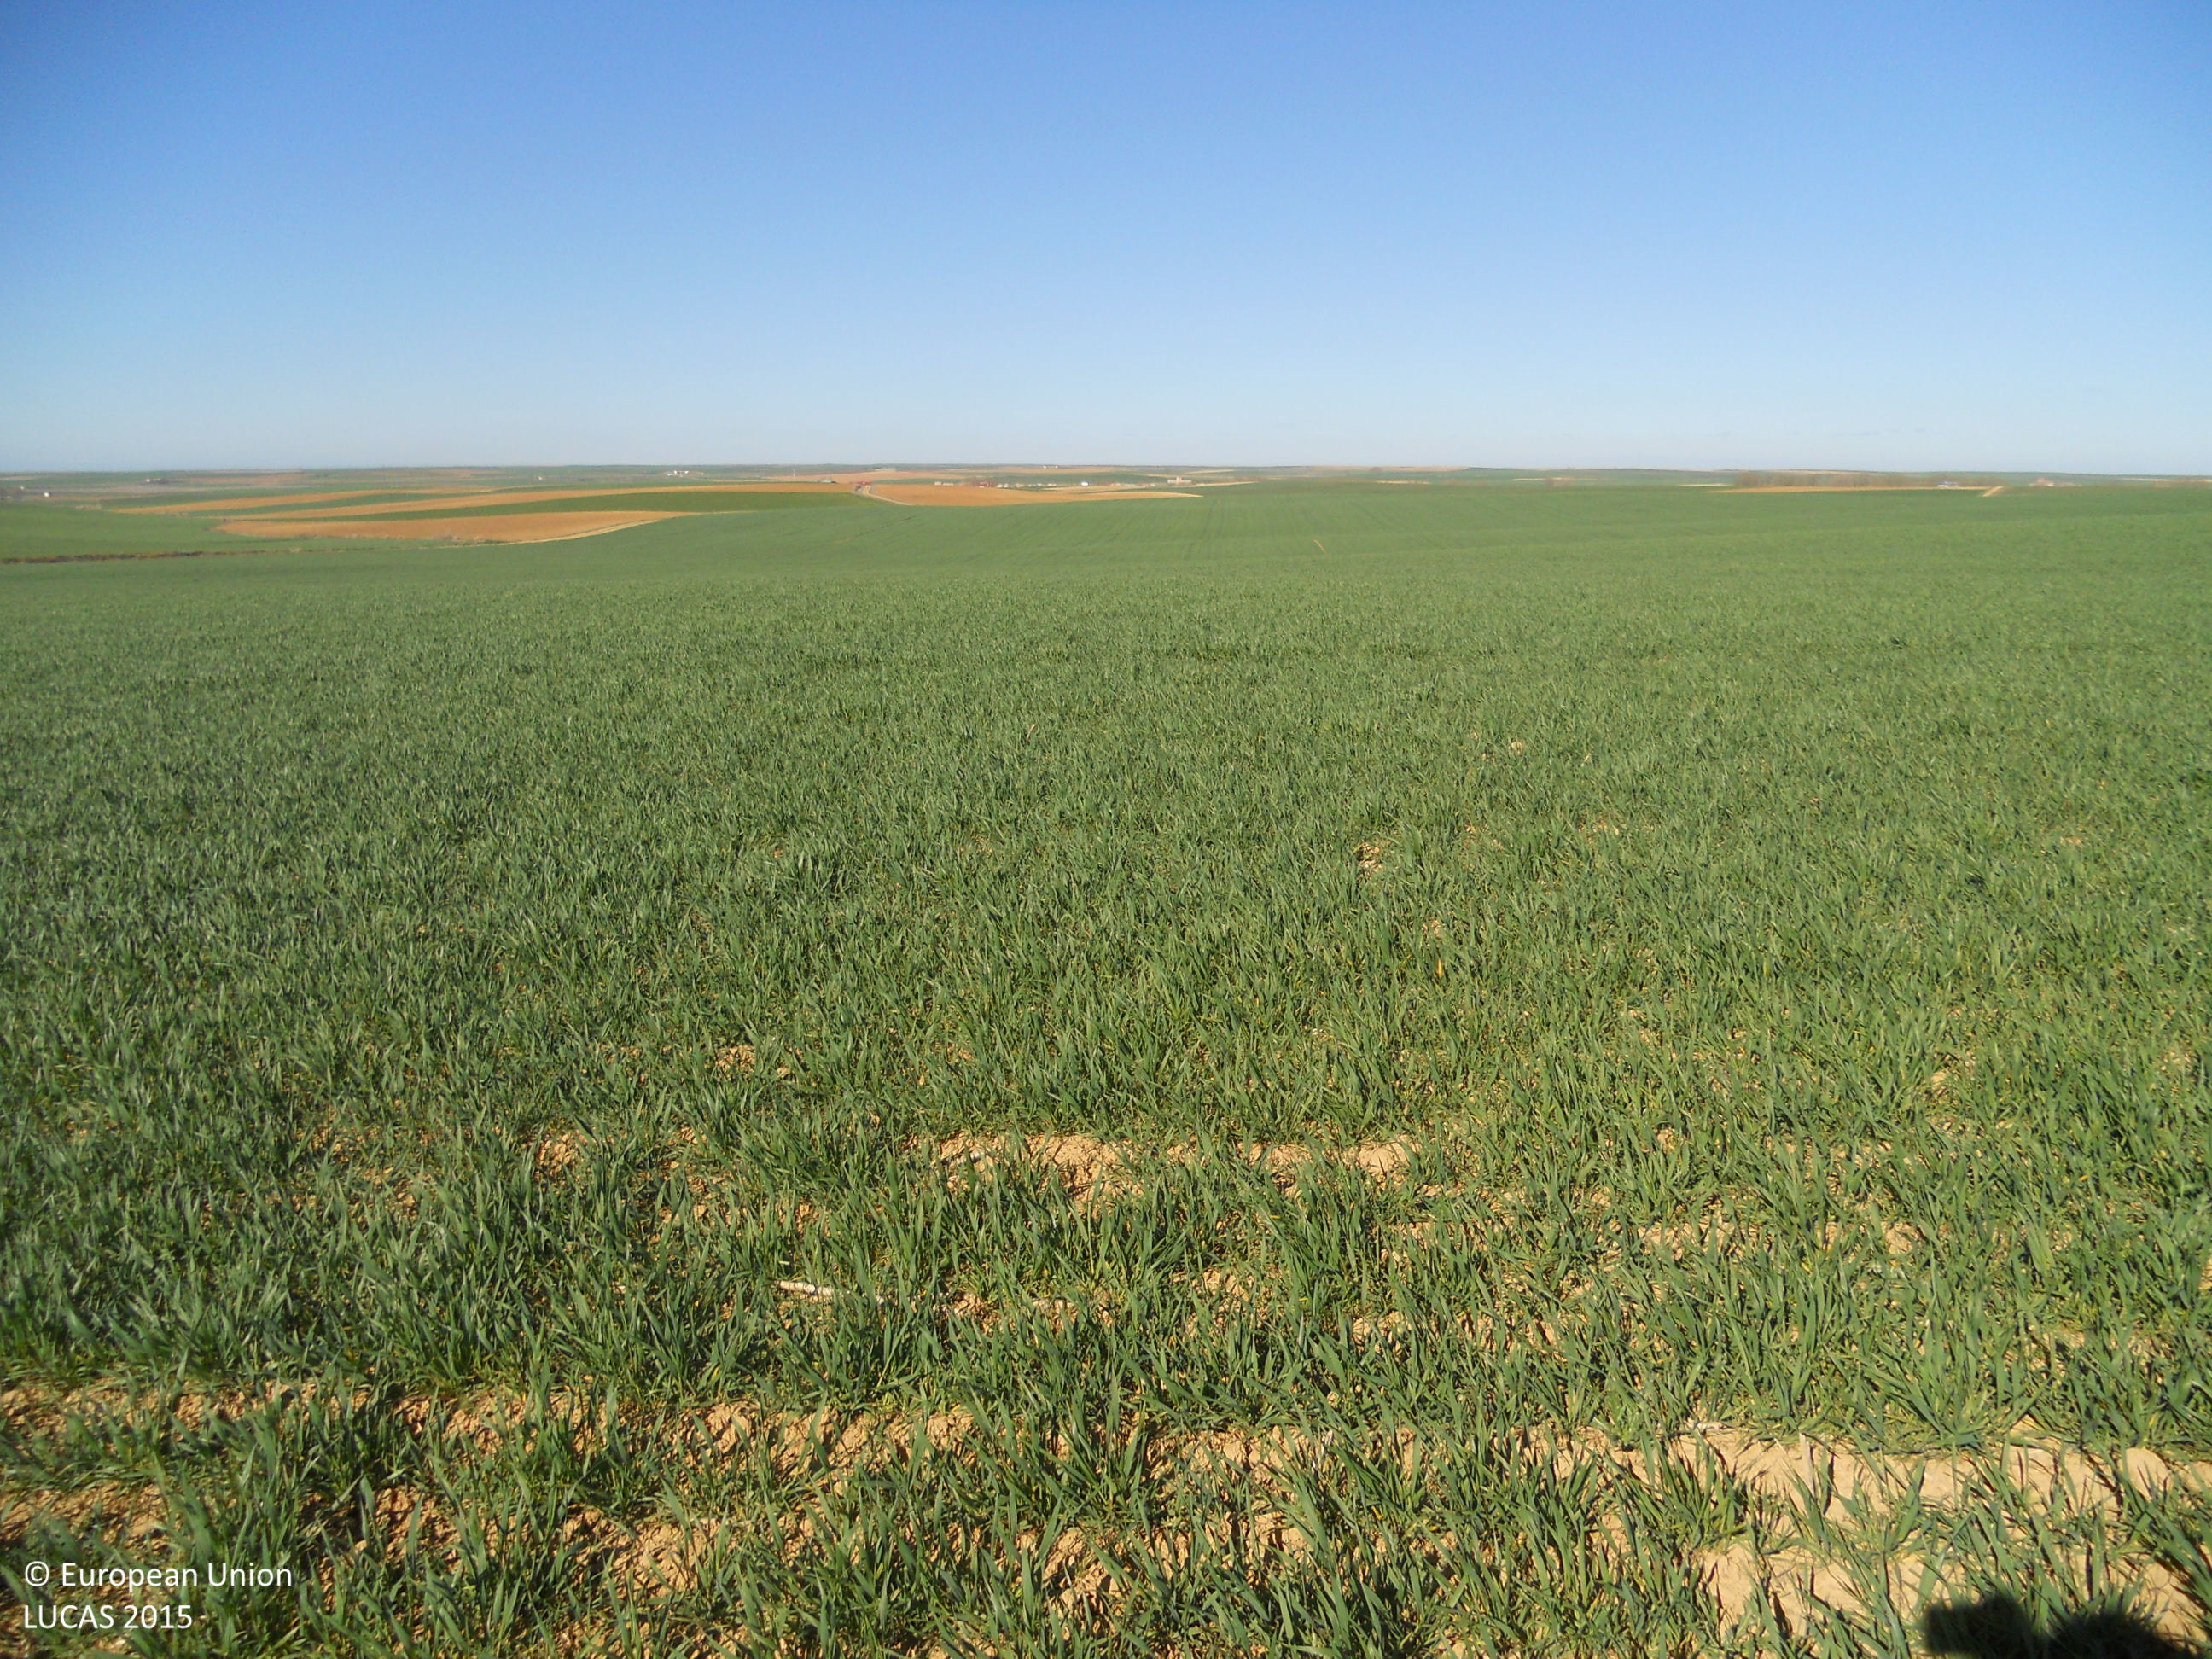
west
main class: Cropland
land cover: Barley
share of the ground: > 75 %
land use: Agriculture (excluding fallow land and kitchen gardens)
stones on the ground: < 10 %
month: April
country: ES
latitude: 42.2096
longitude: -4.7447
